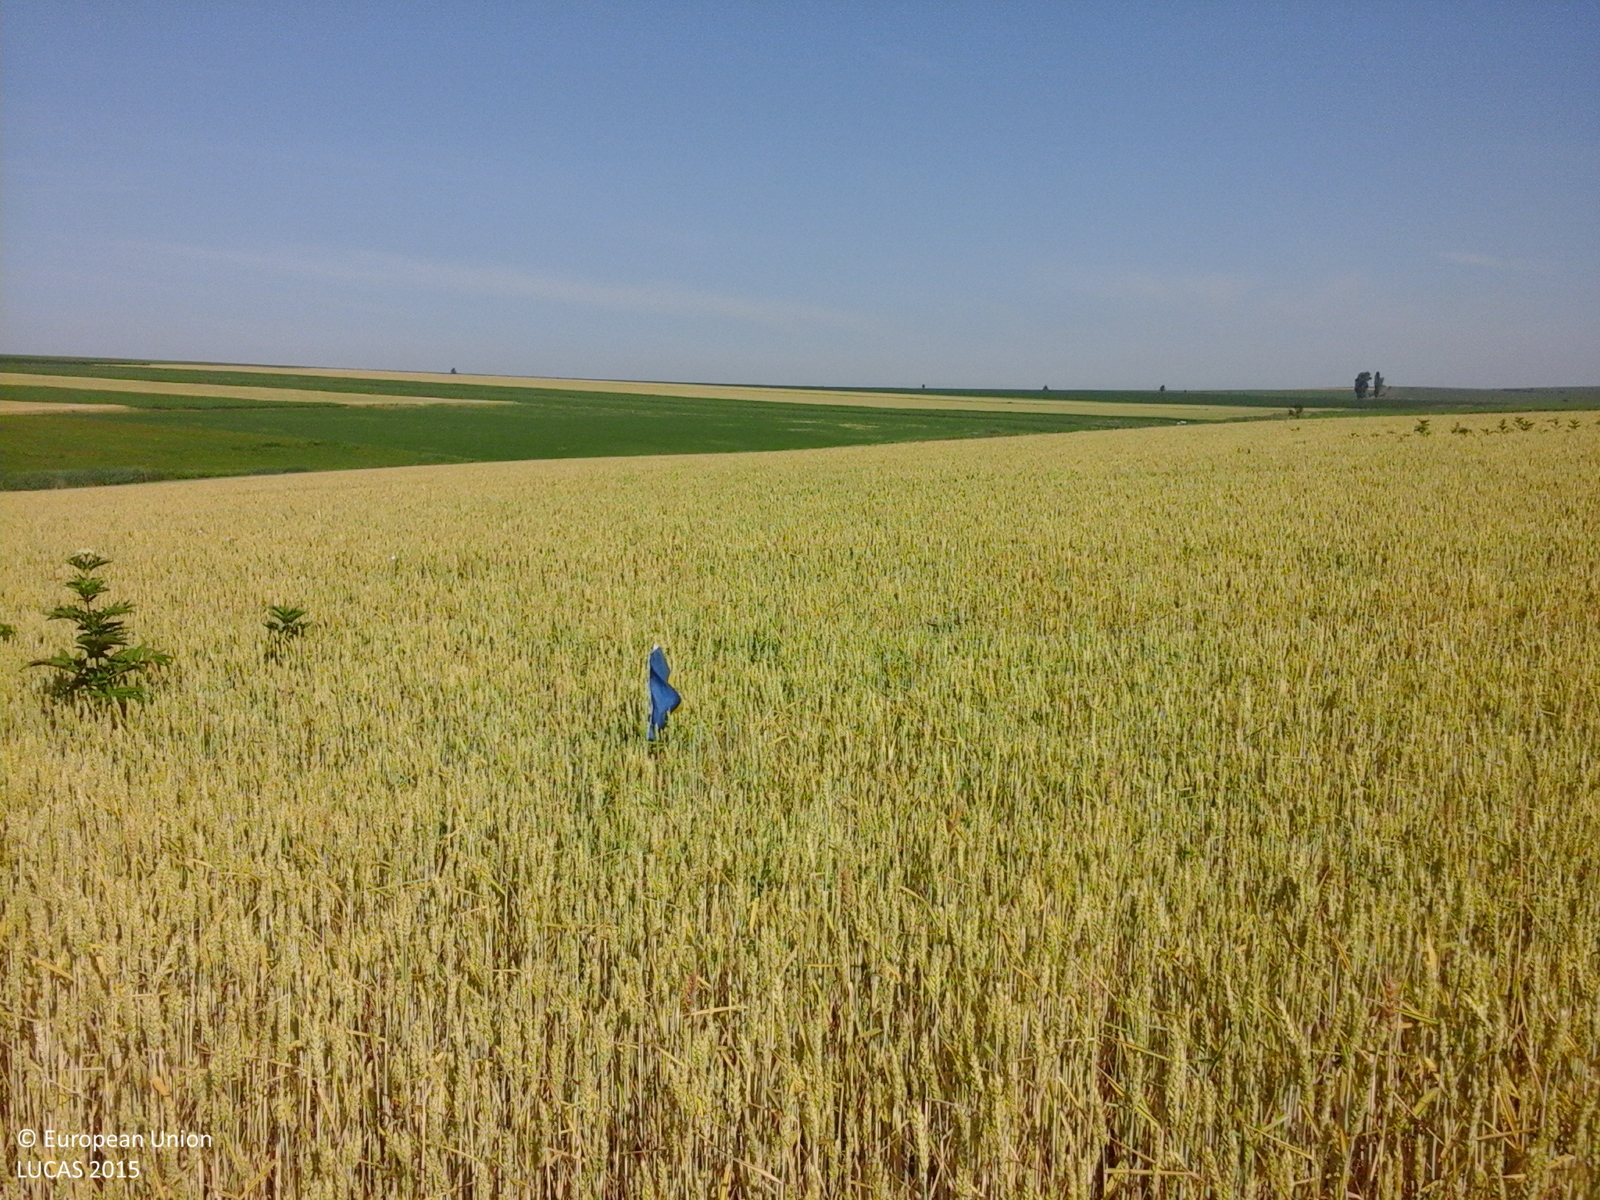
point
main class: Cropland
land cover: Common wheat
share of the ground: > 75 %
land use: Agriculture (excluding fallow land and kitchen gardens)
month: June
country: RO
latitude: 47.6804
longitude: 27.1185
